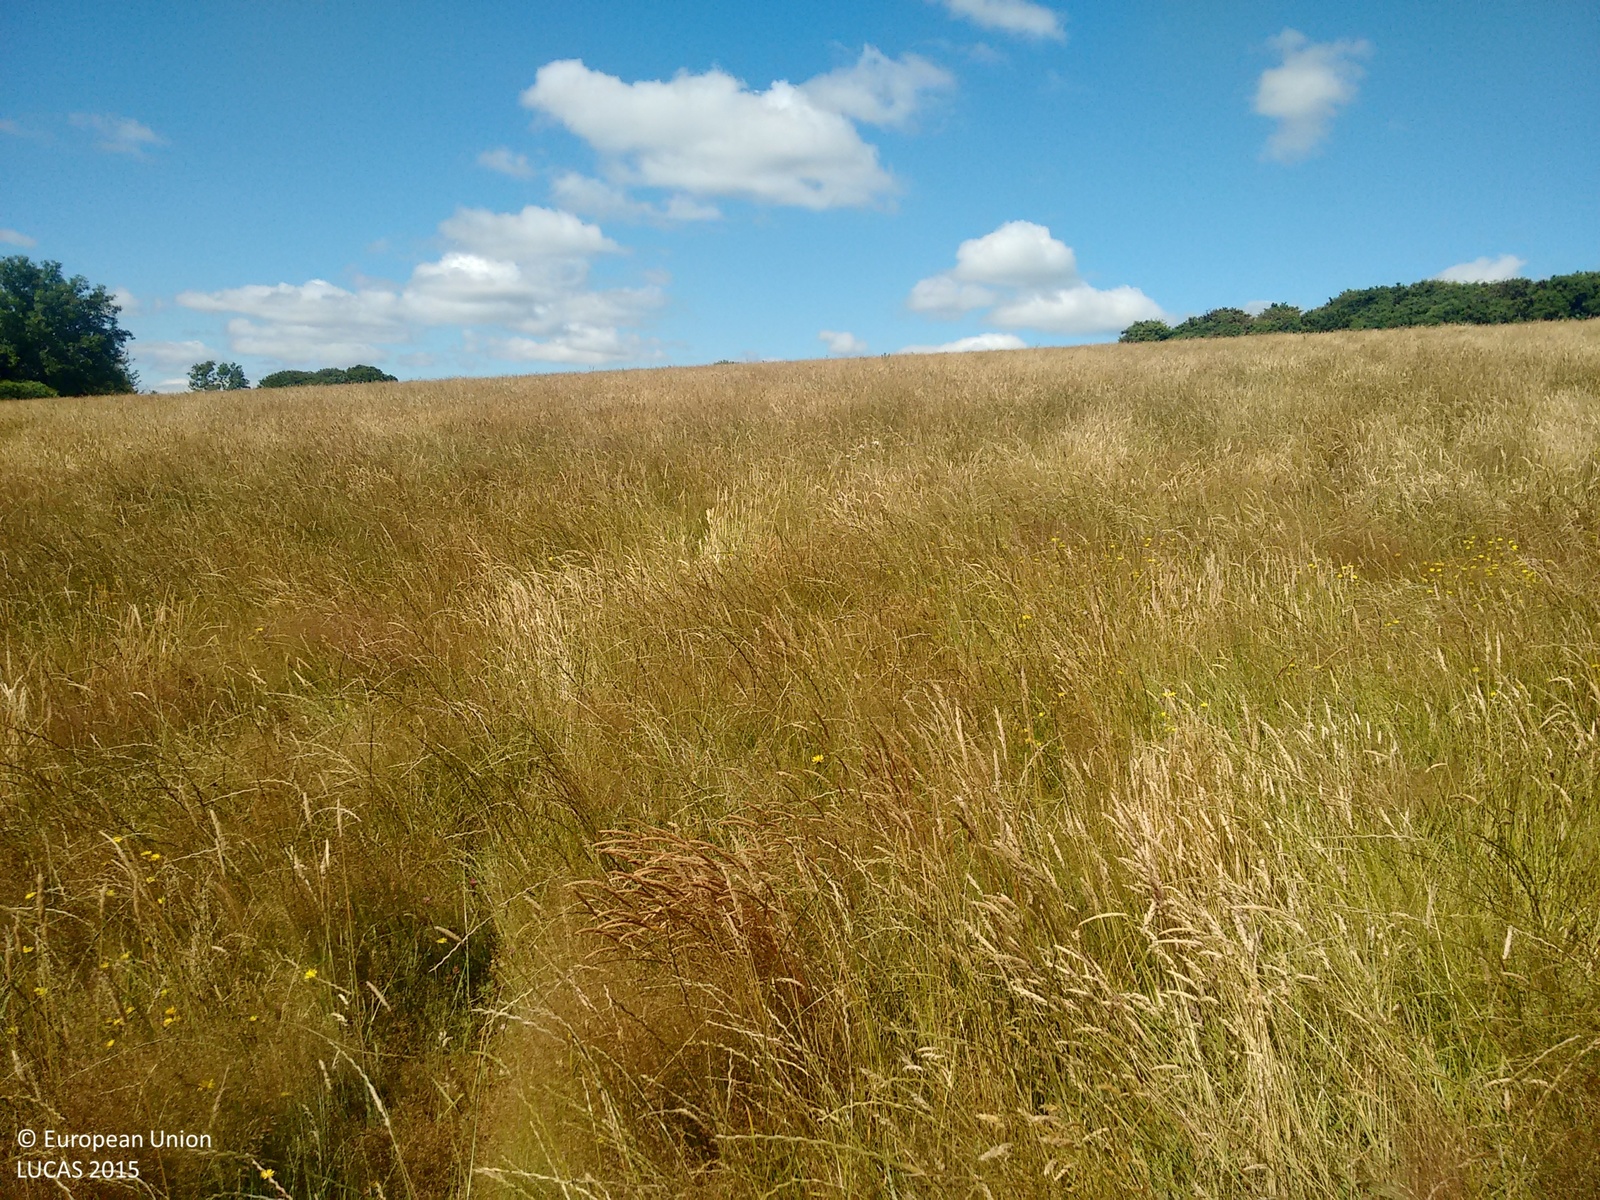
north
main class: Grassland
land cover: Grassland without tree/shrub cover
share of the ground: > 75 %
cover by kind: herbaceous plants 100 %
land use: Agriculture (excluding fallow land and kitchen gardens)
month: July
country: GB
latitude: 50.5453
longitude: -3.7921
